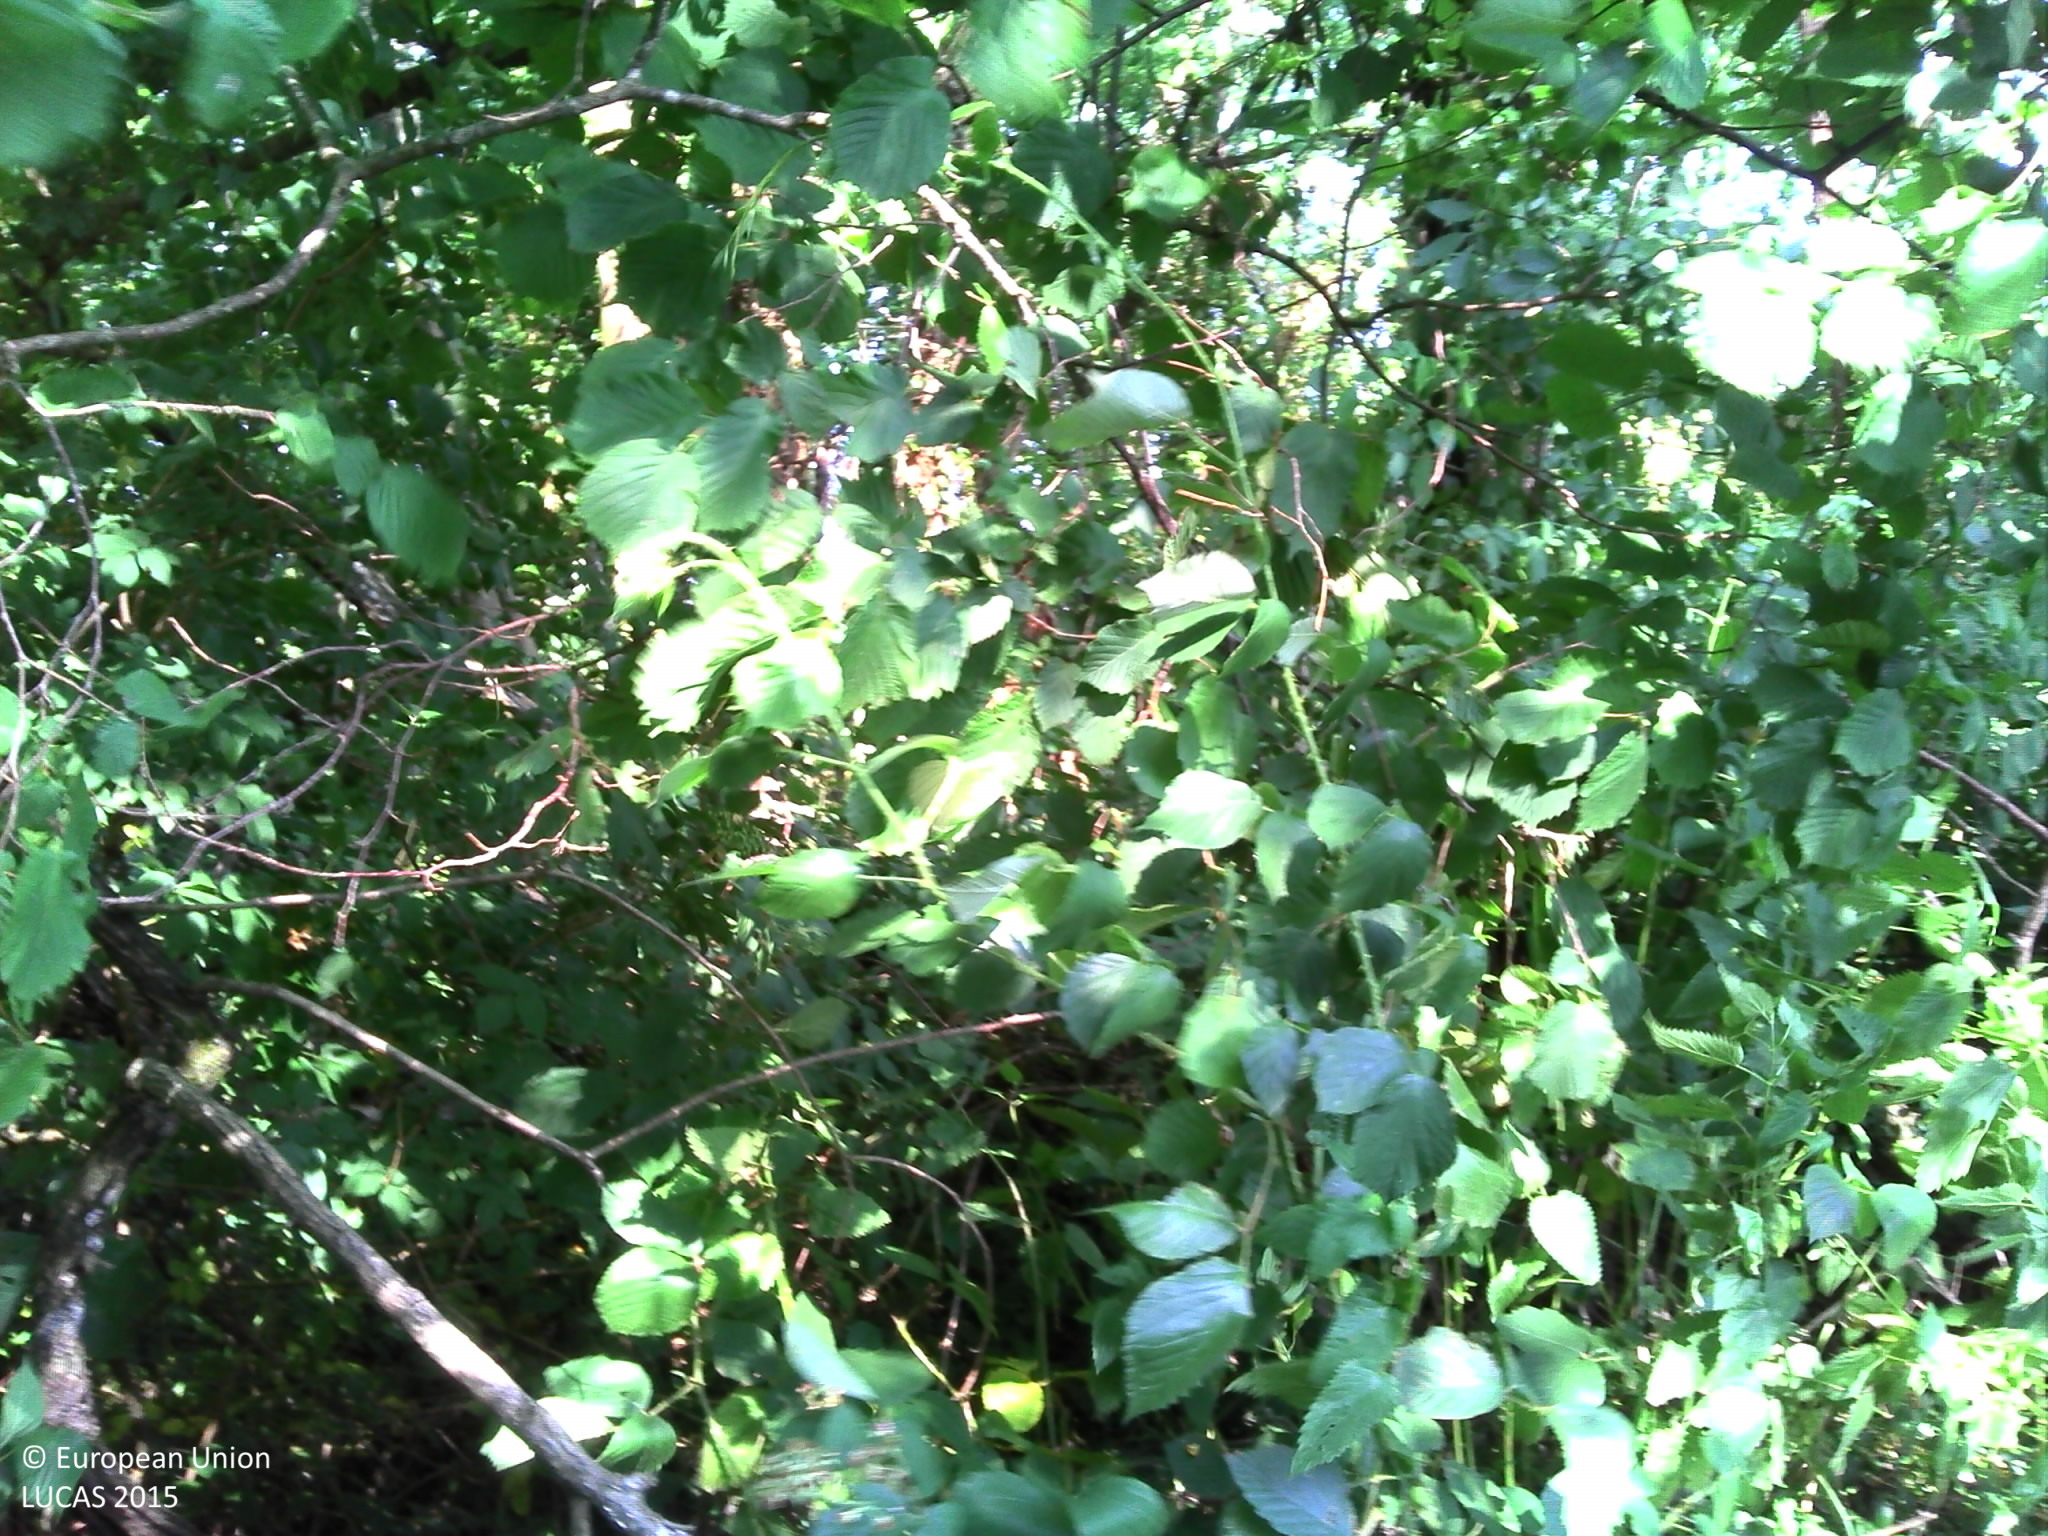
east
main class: Woodland
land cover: Broadleaved woodland
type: mesophytic deciduous forest
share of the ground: > 75 %
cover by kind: broadleaved forest trees 100 %
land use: Forestry
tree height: > 5 m
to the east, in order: Broadleaved woodland; Shrubland without tree cover; Grass margins; Paved roads, cycling and walking lanes; Grass margins; Broadleaved woodland; Grassland without tree/shrub cover; Broadleaved woodland; Managed hedges; Artificial constructions in urban areas
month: July
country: FR
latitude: 45.6219
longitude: 5.4257
